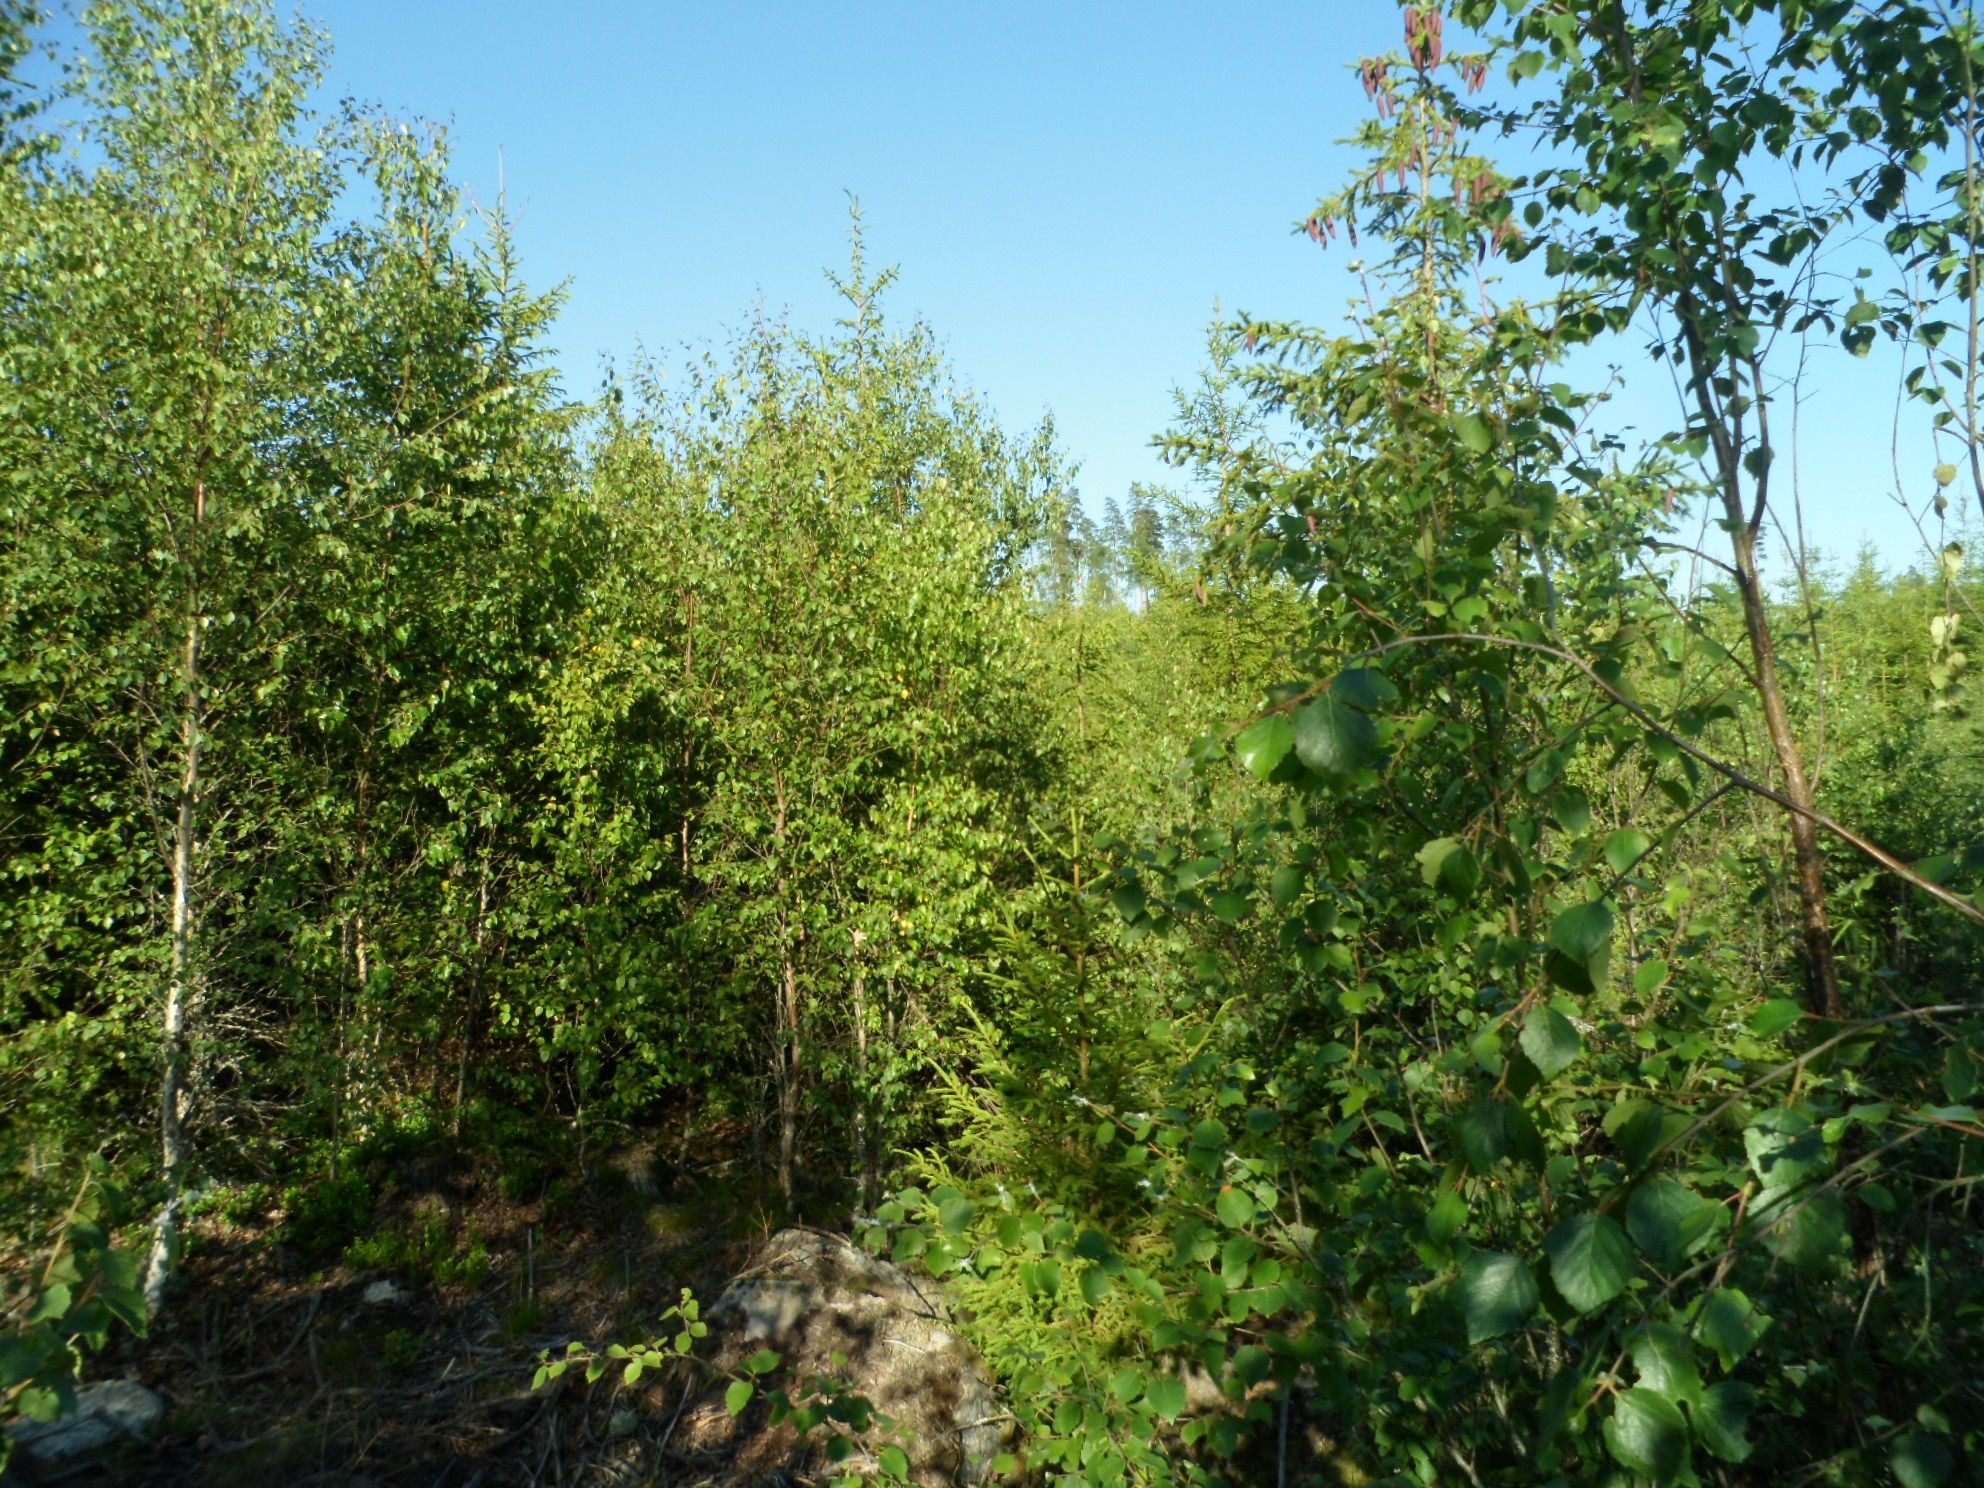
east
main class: Woodland
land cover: Spruce dominated mixed woodland
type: boreal forest
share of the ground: 50 - 75 %
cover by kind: broadleaved forest trees 40 %, coniferous forest trees 35 %, shrubs 10 %, herbaceous plants 10 %, lichens and mosses 5 %
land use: Forestry
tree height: < 5 m
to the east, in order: Spruce dominated mixed woodland; Spruce dominated coniferous woodland; Spruce dominated mixed woodland; Paved roads, cycling and walking lanes; Spruce dominated mixed woodland
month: July
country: SE
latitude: 57.1206
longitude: 14.4061
